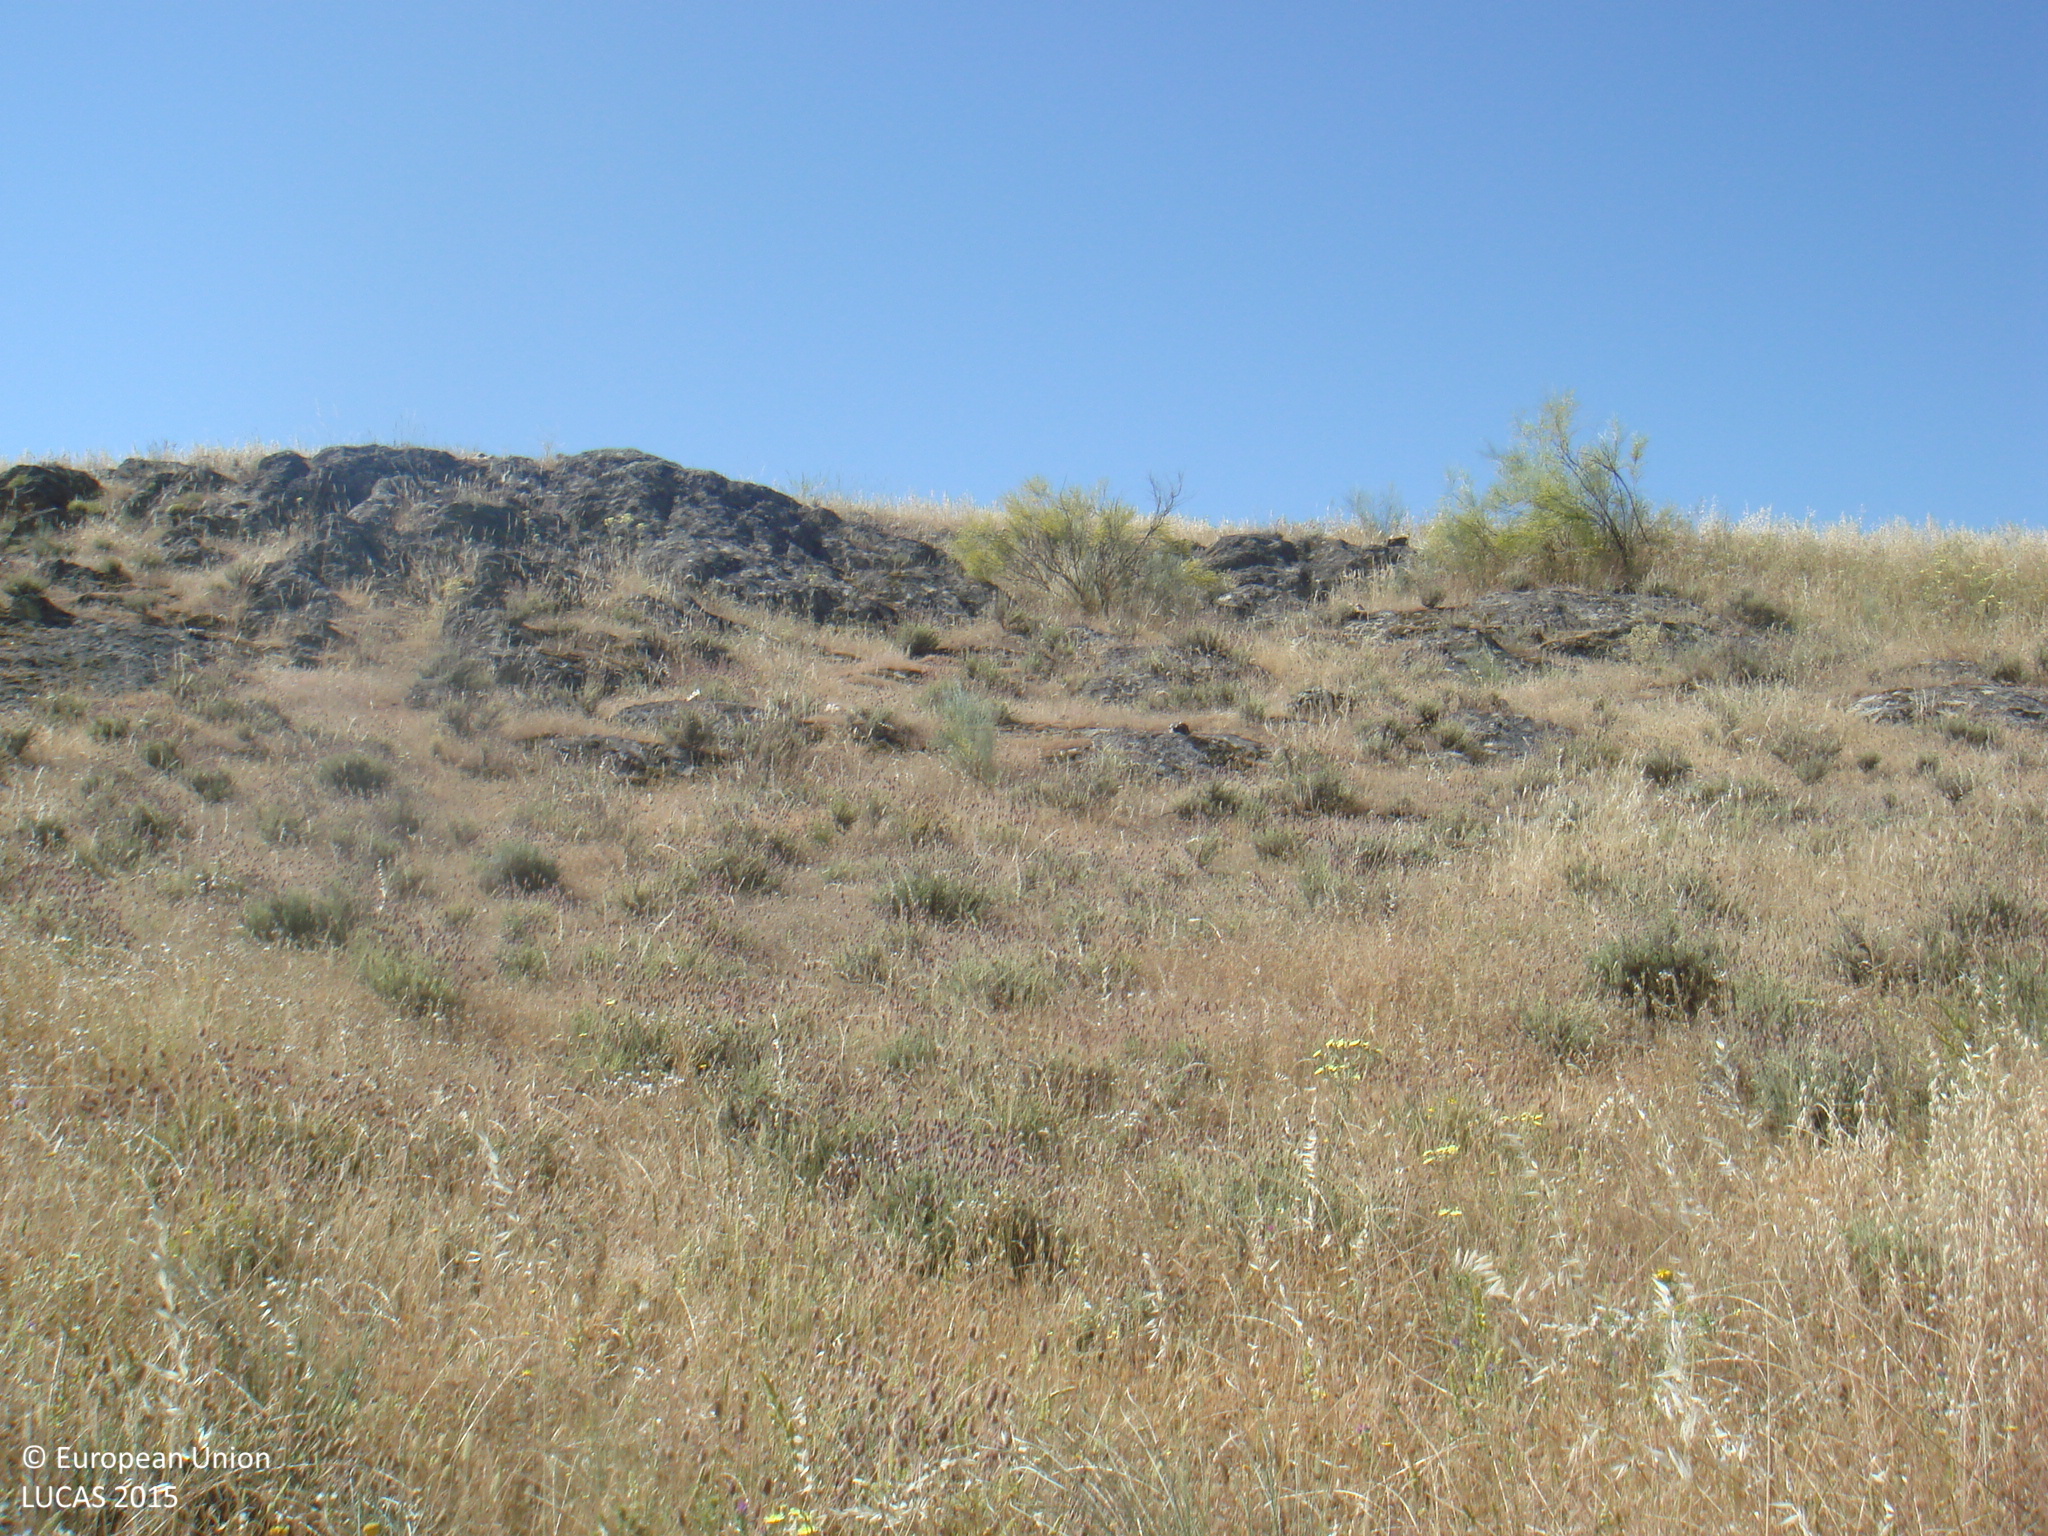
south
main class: Cropland
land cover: Oats
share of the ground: 50 - 75 %
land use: Agriculture (excluding fallow land and kitchen gardens)
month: May
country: ES
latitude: 38.6400
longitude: -5.1630
